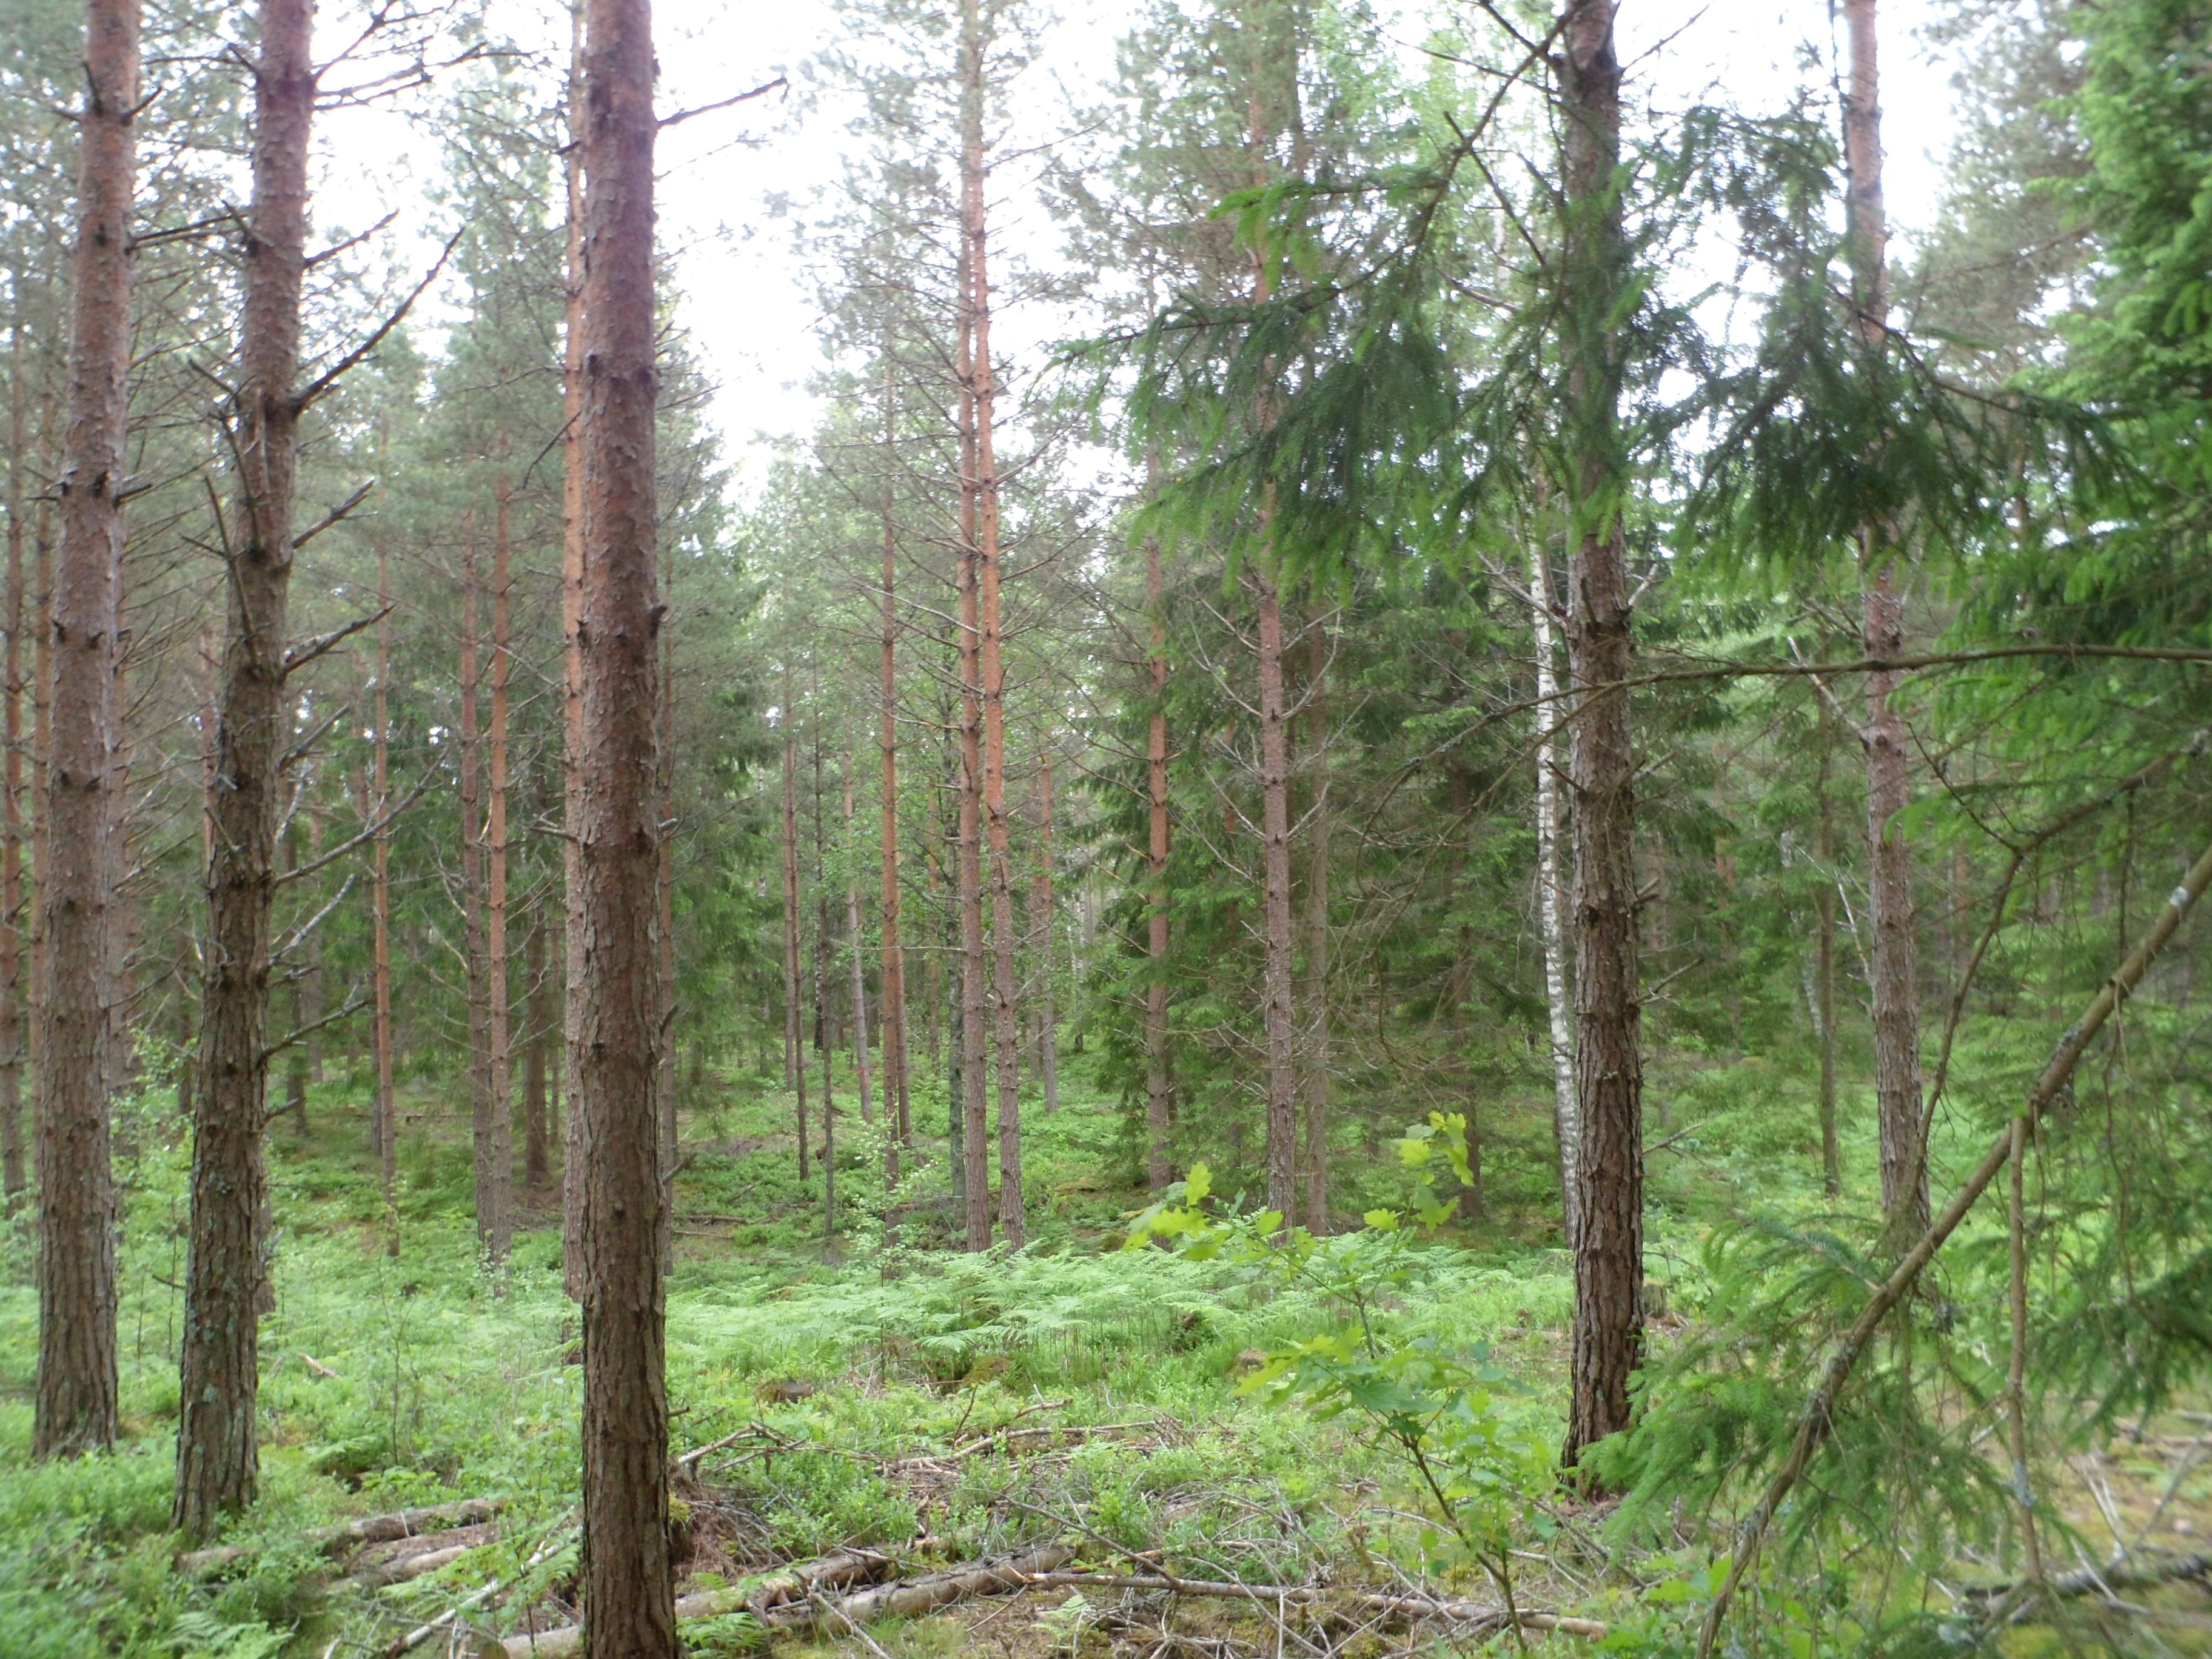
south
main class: Woodland
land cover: Pine dominated coniferous woodland
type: boreal forest
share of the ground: 50 - 75 %
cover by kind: coniferous forest trees 65 %, broadleaved forest trees 10 %, shrubs 10 %, lichens and mosses 10 %, herbaceous plants 5 %
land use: Forestry
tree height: > 5 m
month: June
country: SE
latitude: 56.9200
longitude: 14.4814
